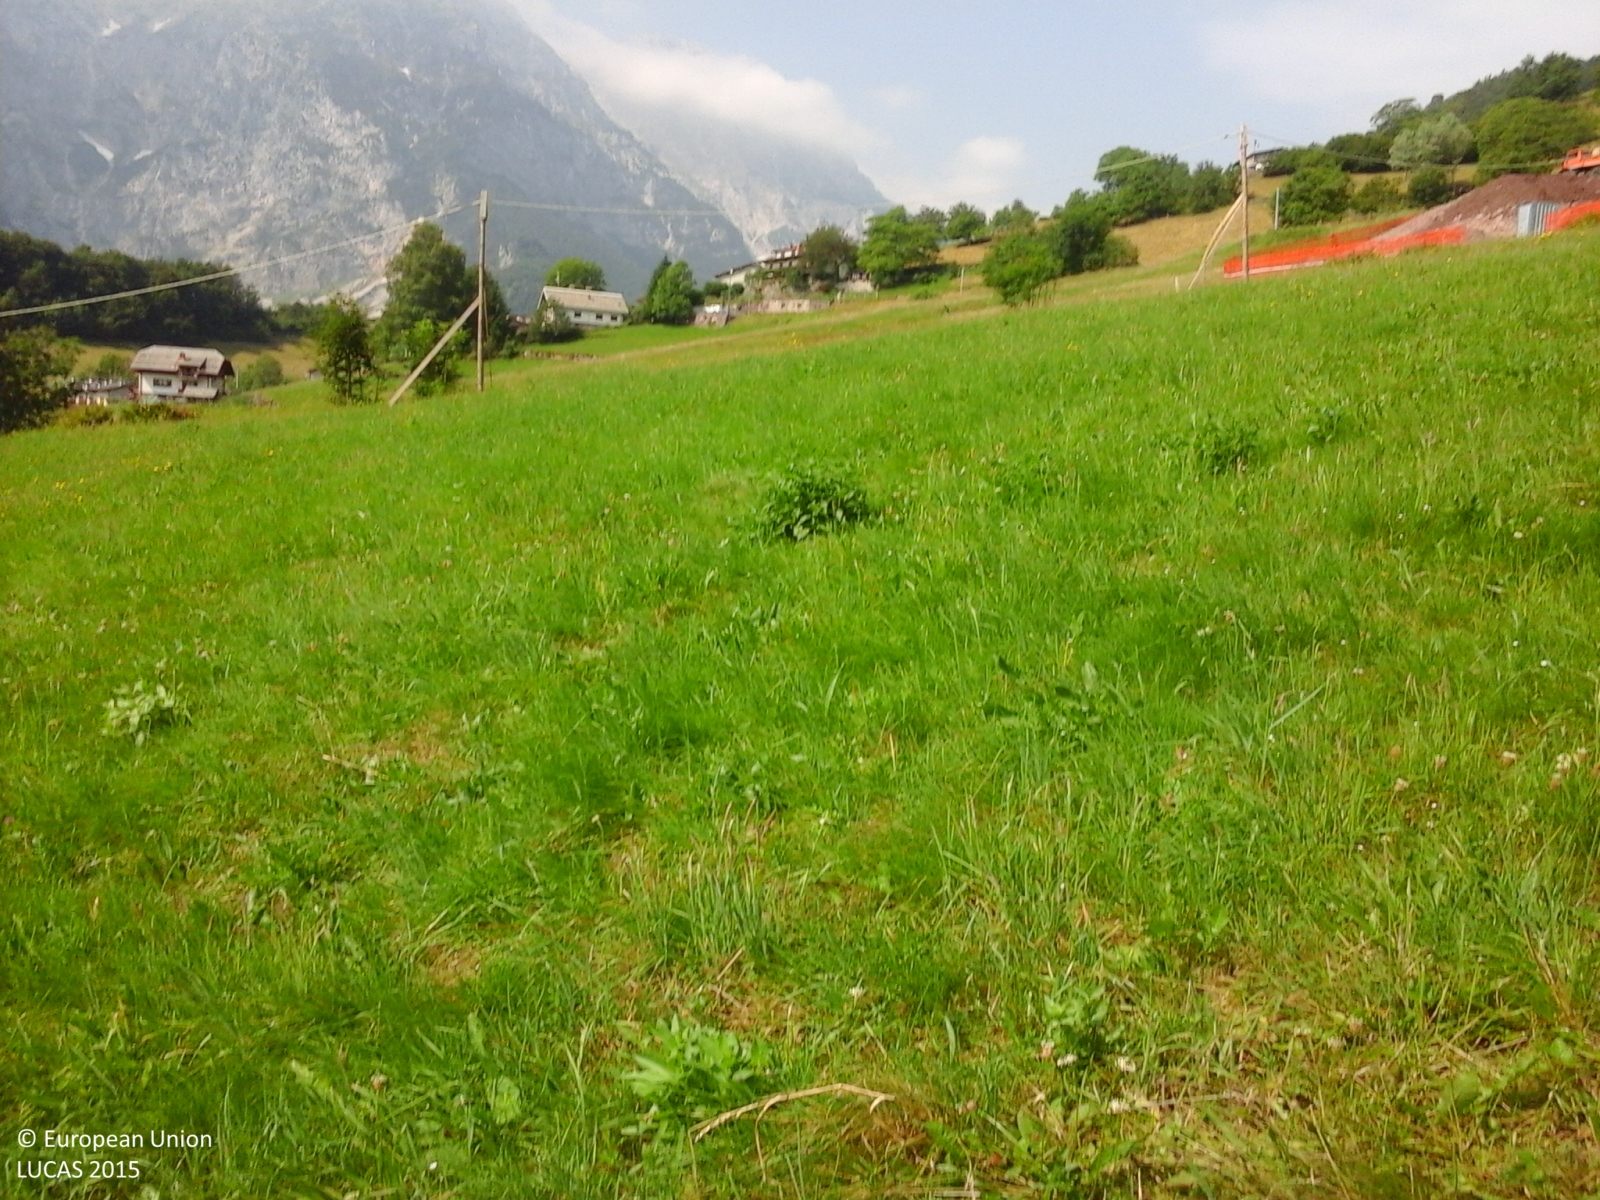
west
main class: Grassland
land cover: Grassland without tree/shrub cover
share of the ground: > 75 %
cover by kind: herbaceous plants 100 %
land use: Agriculture (excluding fallow land and kitchen gardens)
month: July
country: IT
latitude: 45.9548
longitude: 9.9098
